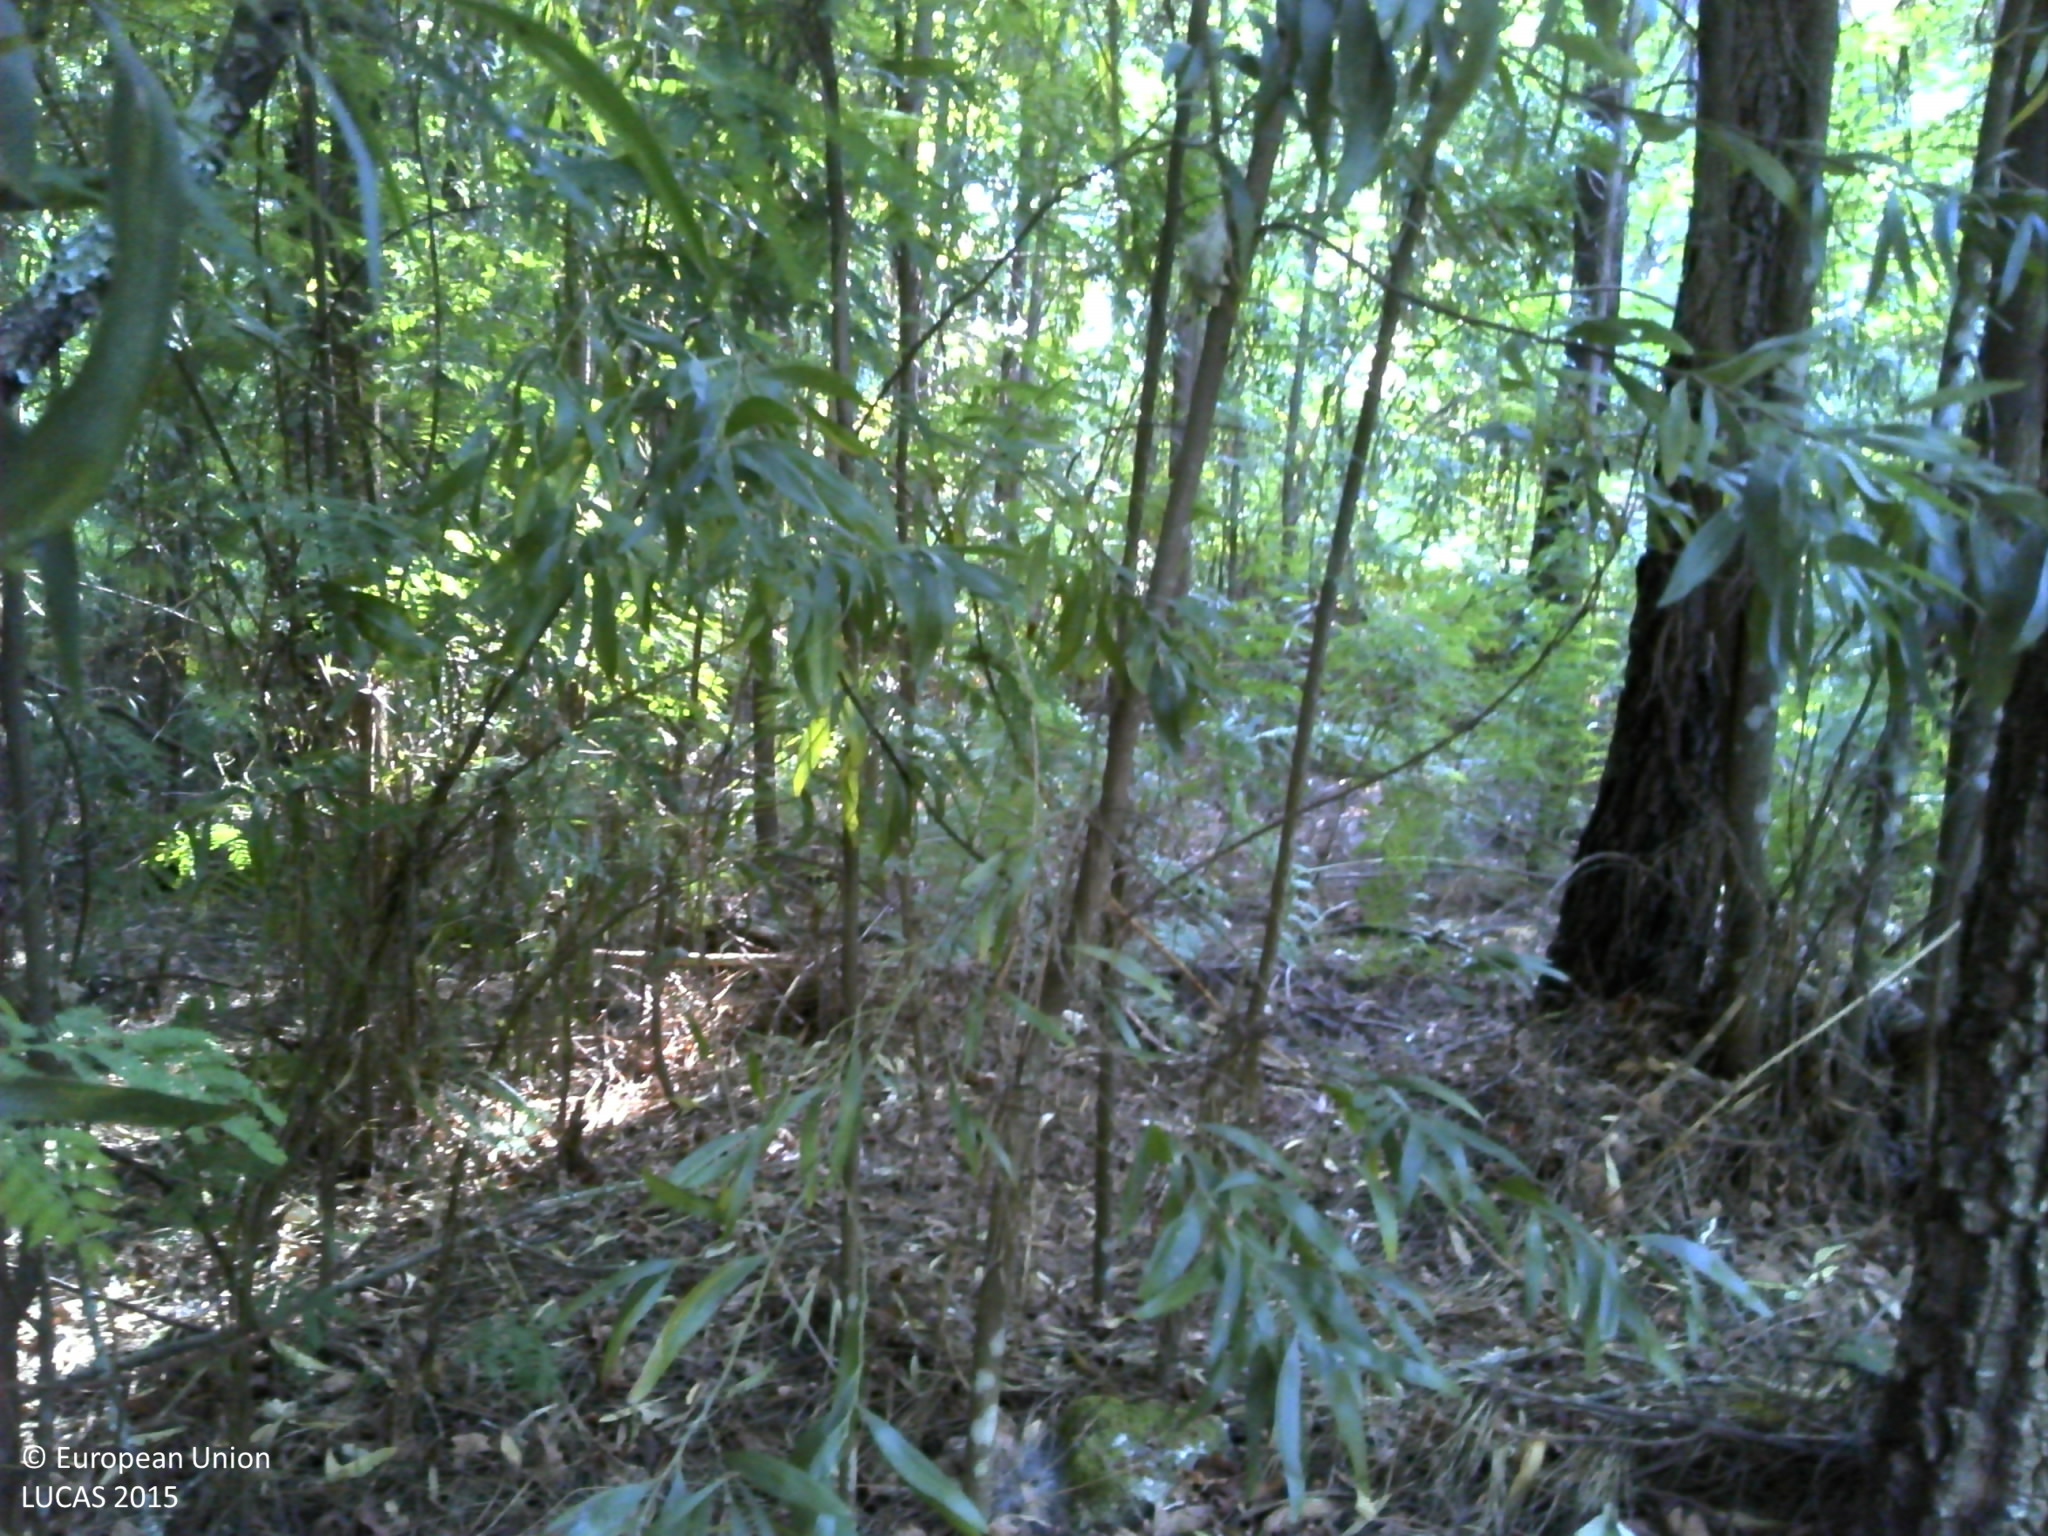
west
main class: Woodland
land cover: Broadleaved woodland
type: thermophilous deciduous forest
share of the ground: 10 - 25 %
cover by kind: broadleaved forest trees 75 %, unconsolidated bare surface 20 %, shrubs 5 %
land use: Forestry
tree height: > 5 m
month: July
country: PT
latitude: 40.7125
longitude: -7.7951
